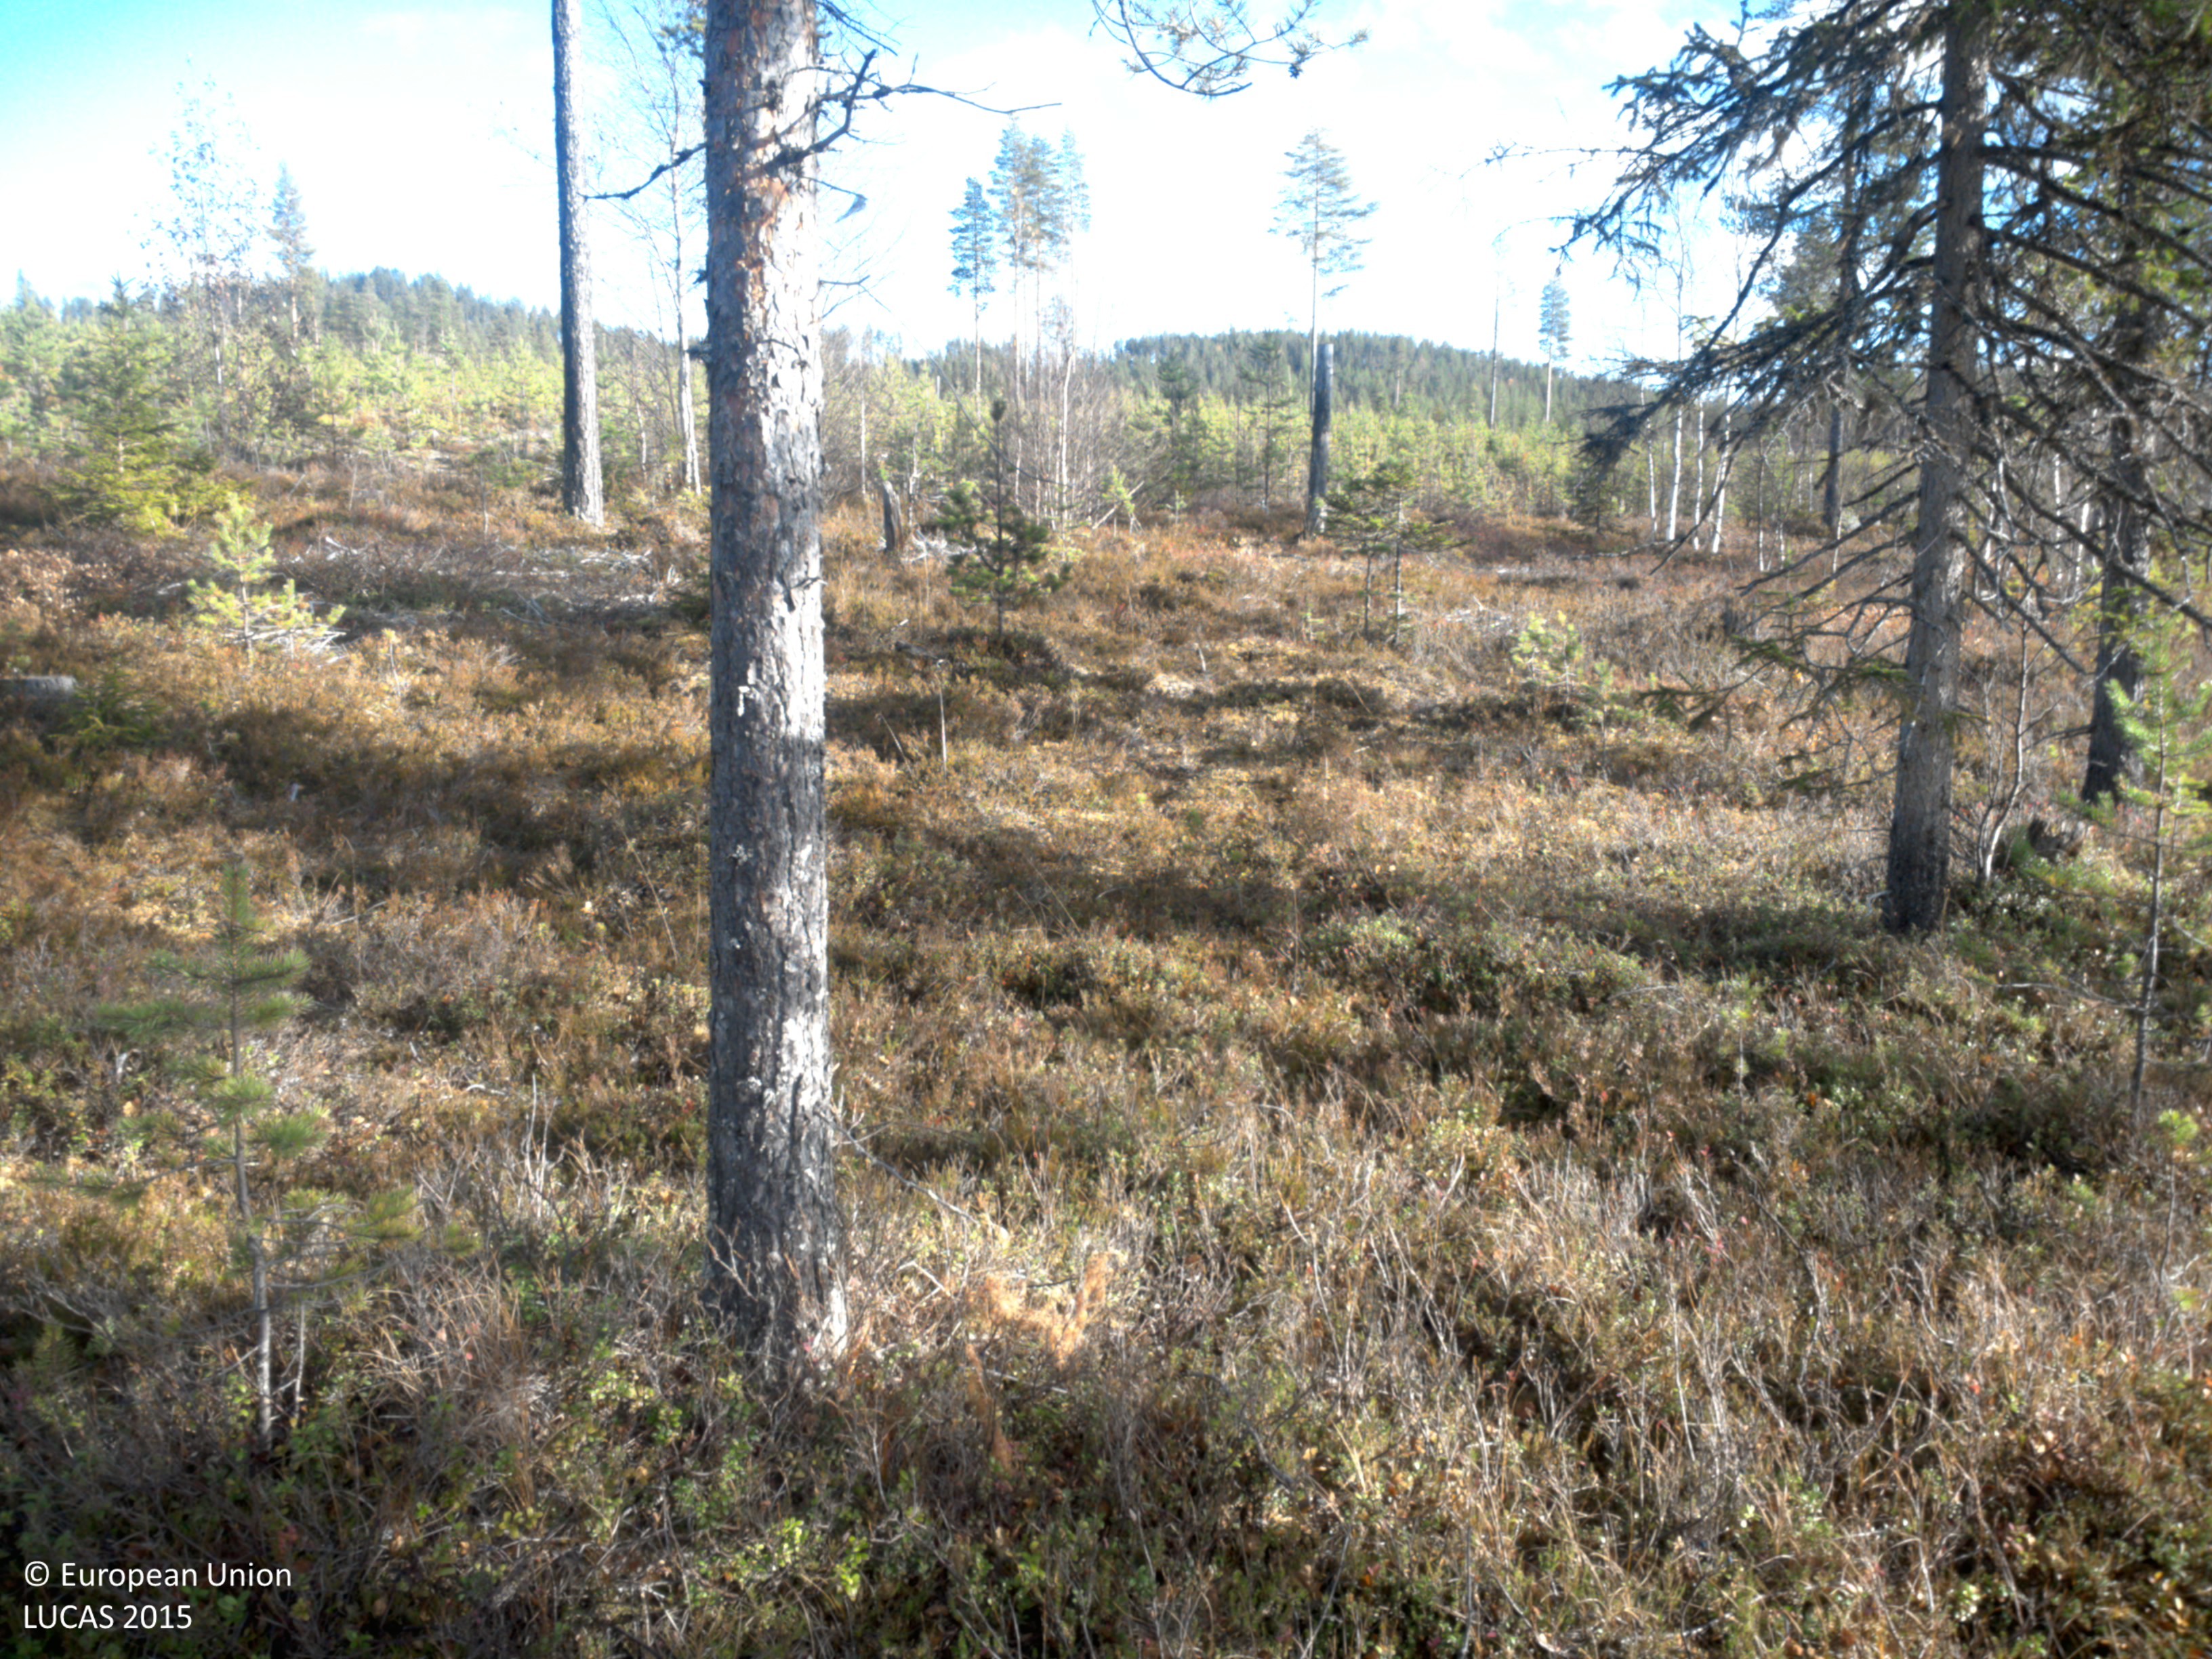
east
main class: Woodland
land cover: Pine dominated mixed woodland
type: boreal forest
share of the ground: 25 - 50 %
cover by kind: shrubs 35 %, herbaceous plants 20 %, coniferous forest trees 15 %, broadleaved forest trees 15 %, lichens and mosses 15 %
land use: Forestry
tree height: > 5 m
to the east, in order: Pine dominated mixed woodland; Paved roads, cycling and walking lanes; Pine dominated coniferous woodland; Shrubland with sparse tree cover
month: October
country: SE
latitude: 64.7733
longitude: 18.4406
